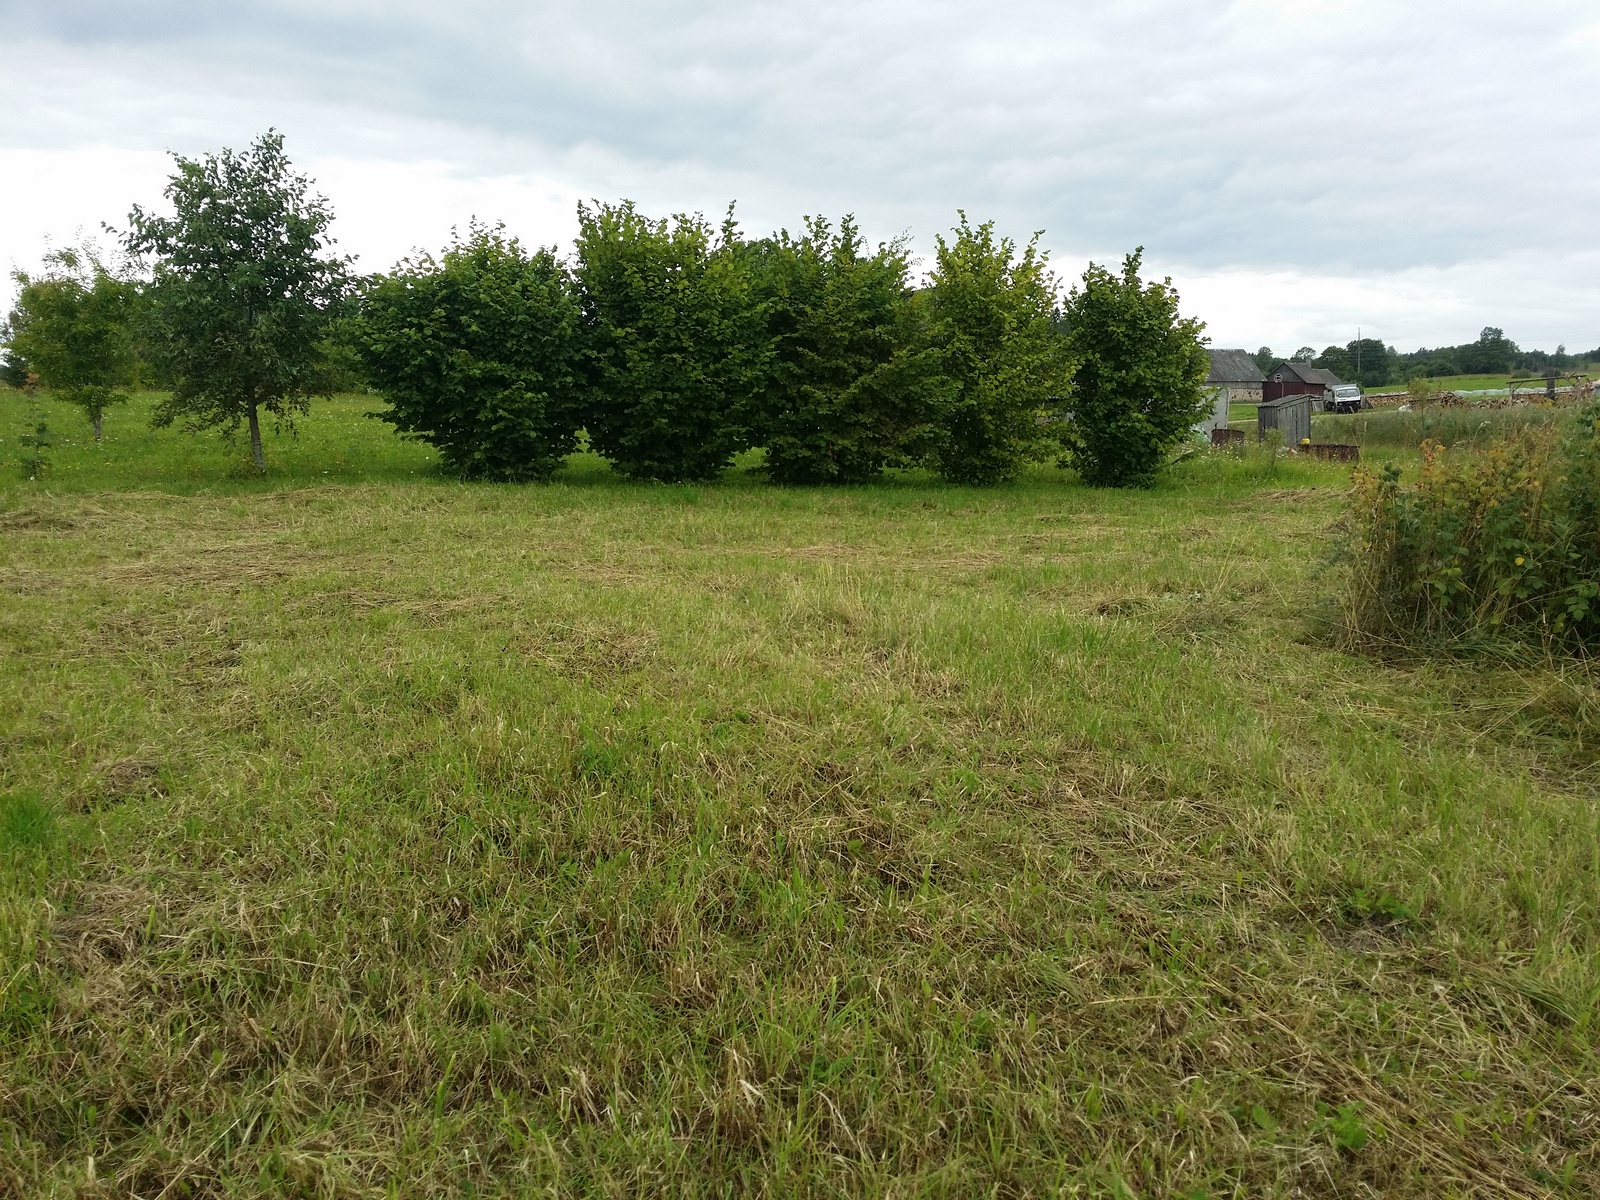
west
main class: Grassland
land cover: Grassland without tree/shrub cover
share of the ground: > 75 %
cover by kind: herbaceous plants 90 %, unconsolidated bare surface 10 %
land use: Agriculture (excluding fallow land and kitchen gardens)
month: August
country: LV
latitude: 57.1932
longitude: 26.7500
